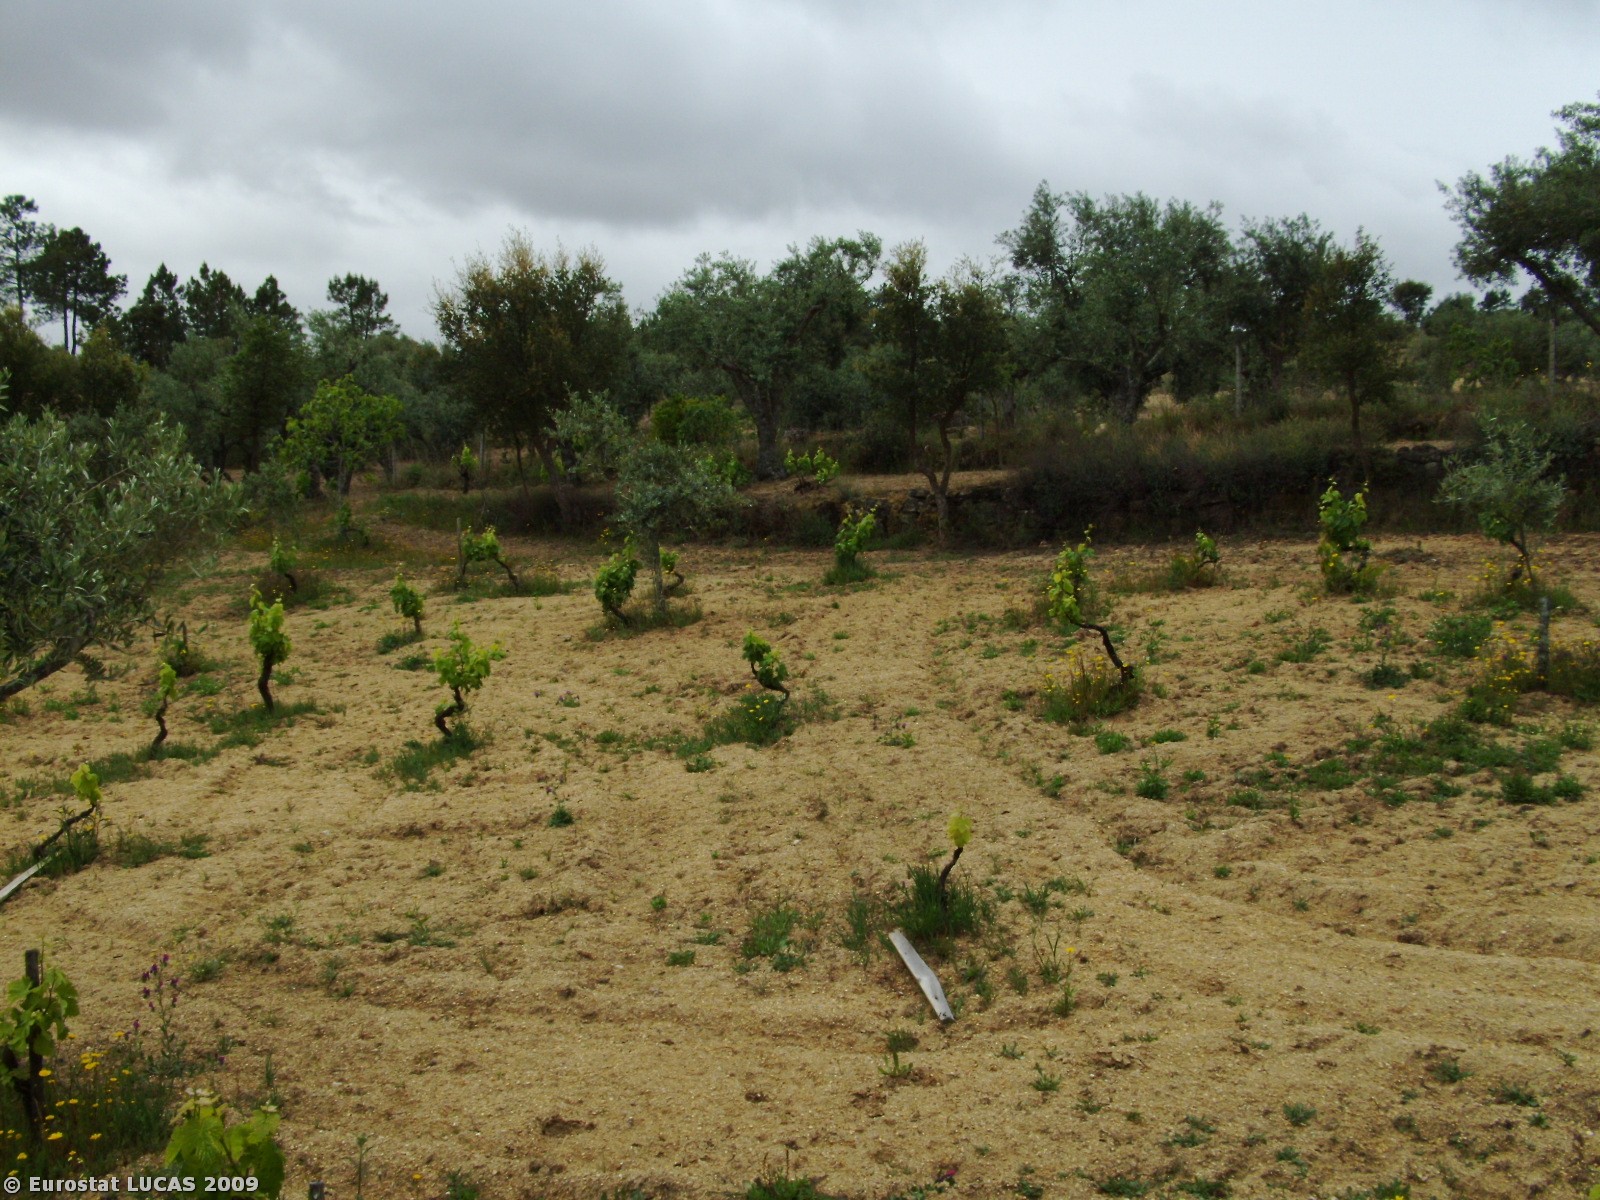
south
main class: Cropland
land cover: Vineyards
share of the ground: 10 - 25 %
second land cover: Bare land
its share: > 75 %
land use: Agriculture (excluding fallow land and kitchen gardens)
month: April
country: PT
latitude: 39.8702
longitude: -7.5563
